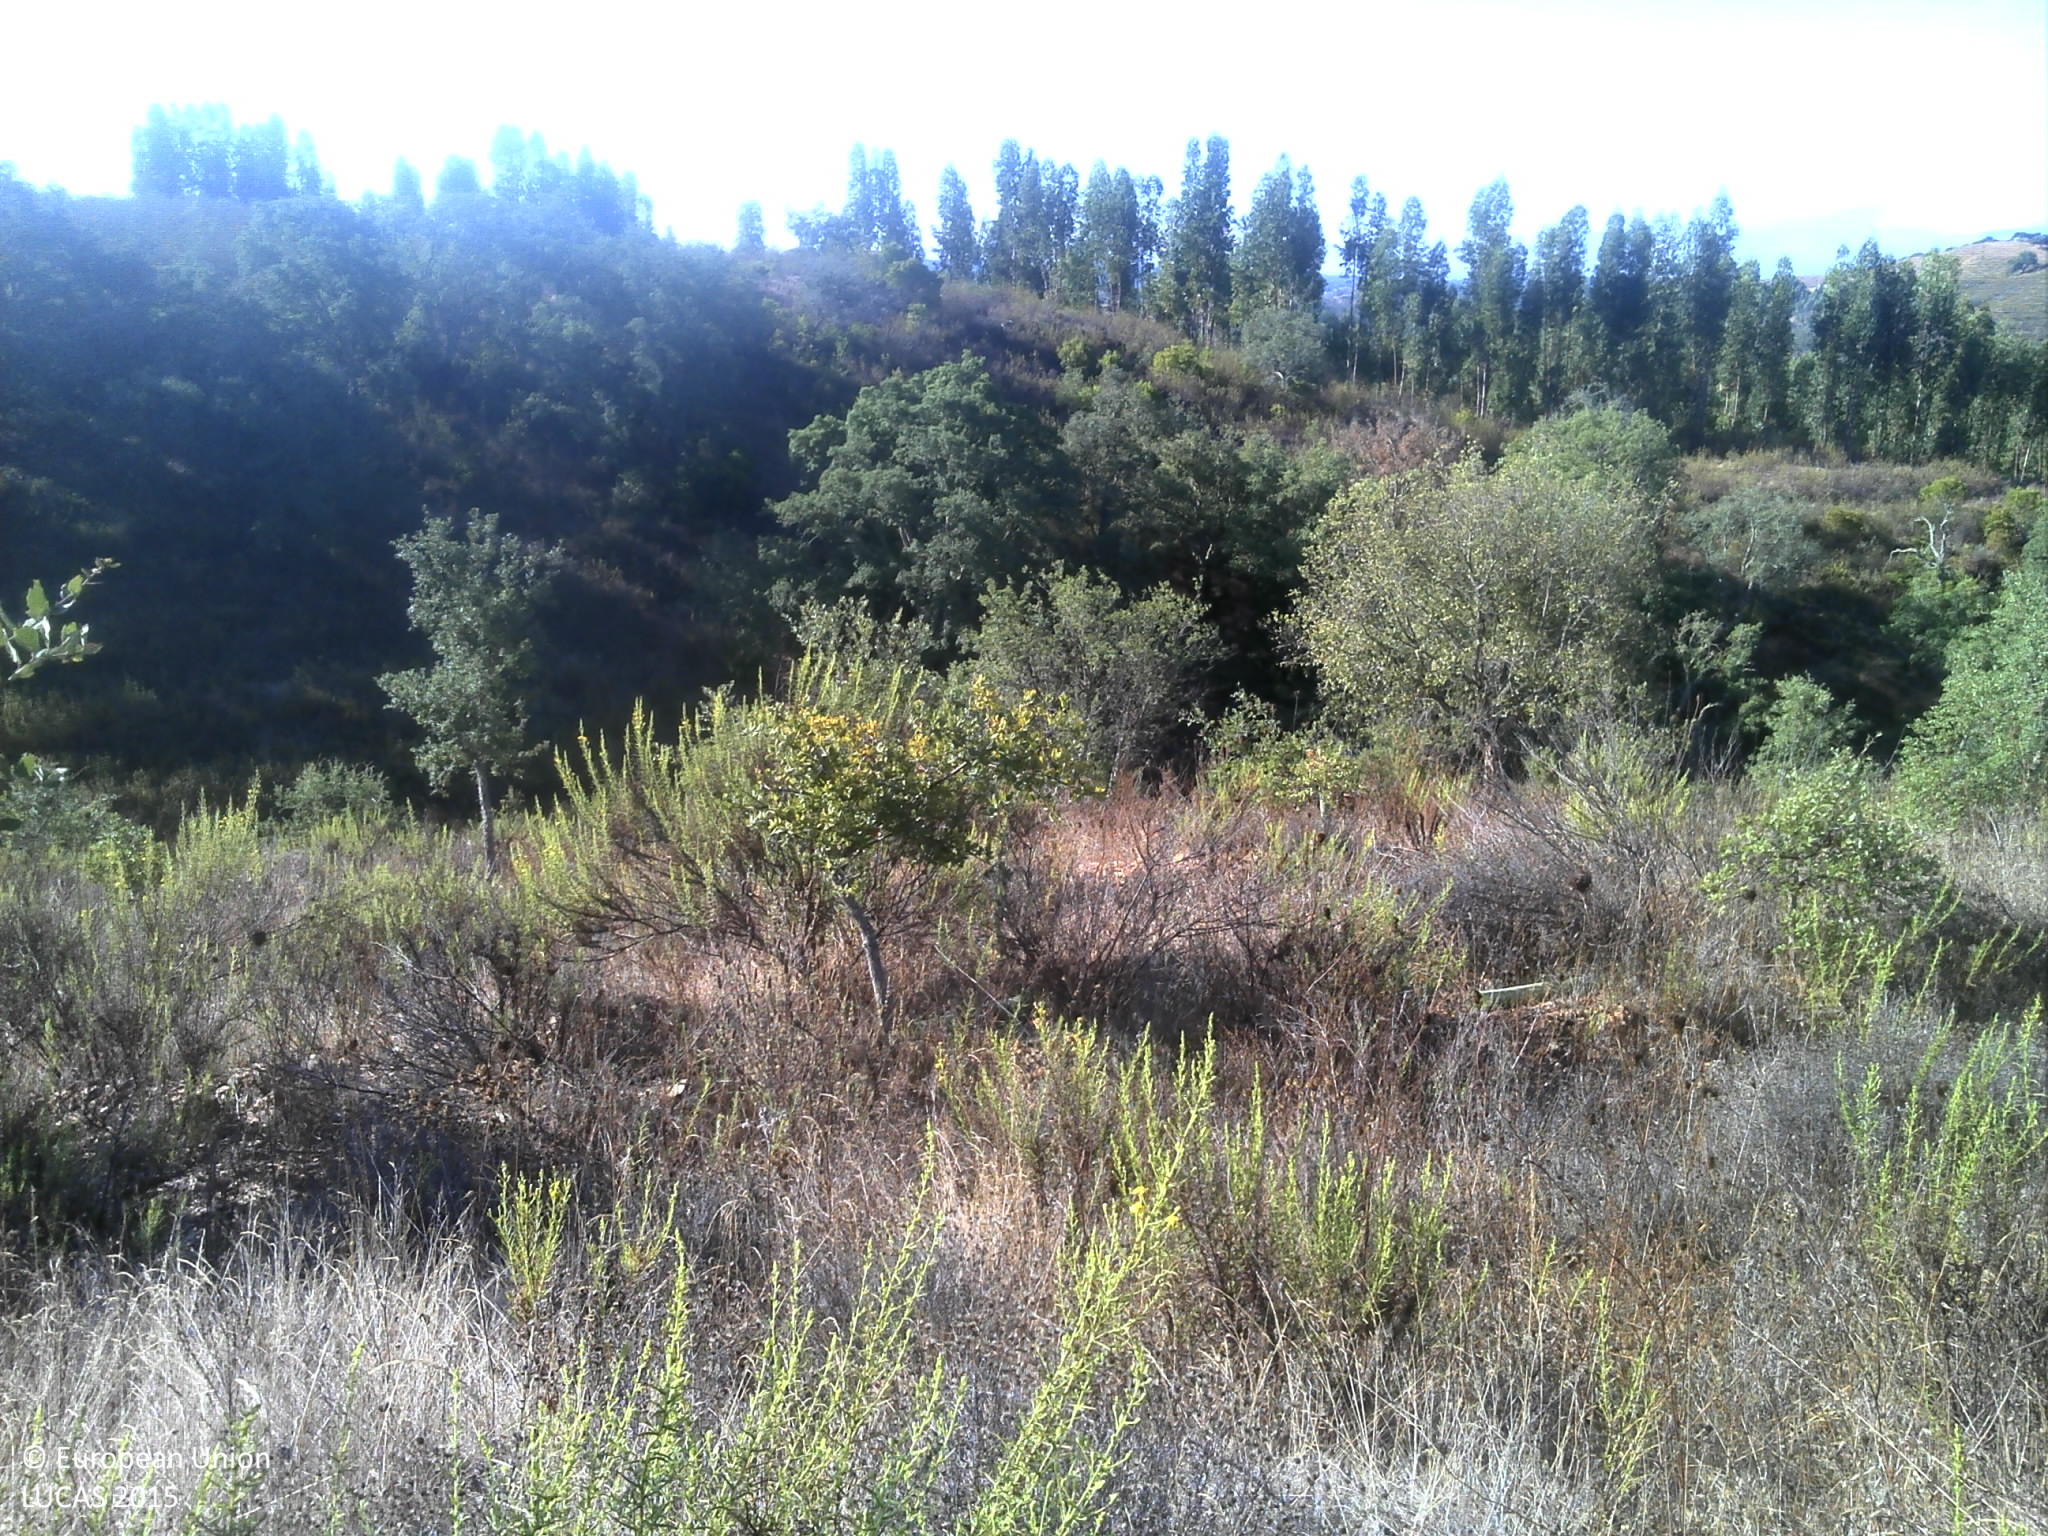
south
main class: Woodland
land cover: Broadleaved woodland
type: broadleaved evergreen forest
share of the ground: 10 - 25 %
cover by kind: shrubs 40 %, unconsolidated bare surface 35 %, broadleaved forest trees 25 %
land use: Forestry
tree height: < 5 m
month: August
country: PT
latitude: 37.5912
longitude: -8.4597
